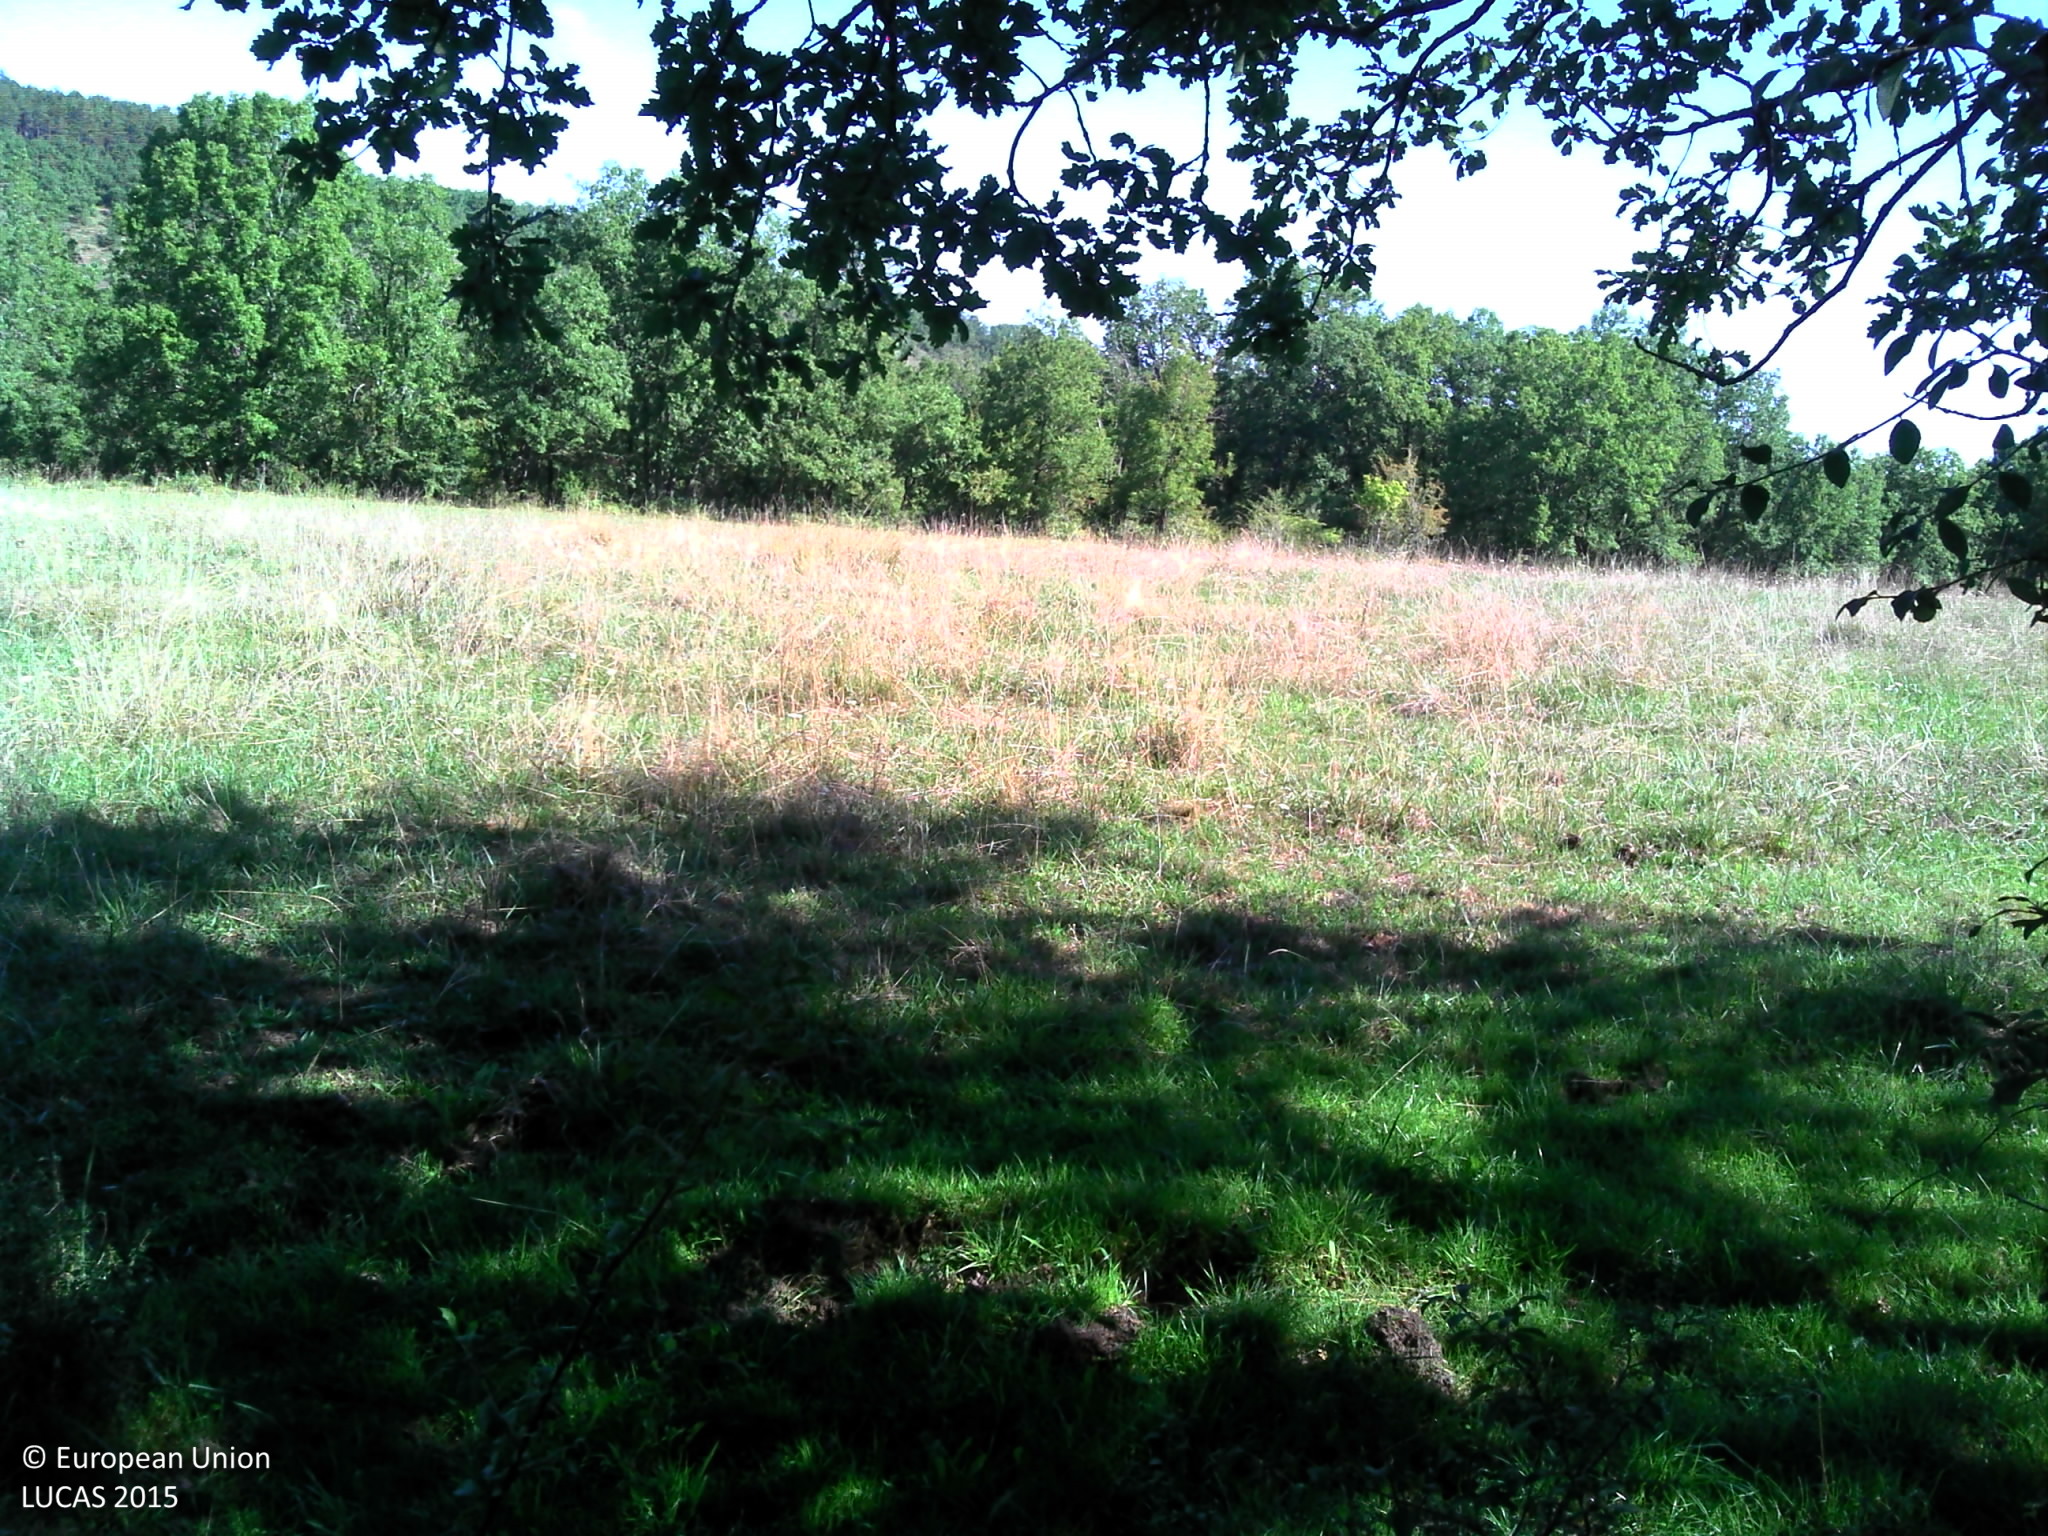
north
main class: Grassland
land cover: Grassland without tree/shrub cover
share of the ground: > 75 %
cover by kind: herbaceous plants 100 %
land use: Agriculture (excluding fallow land and kitchen gardens)
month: August
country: FR
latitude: 44.2508
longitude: 1.8984
